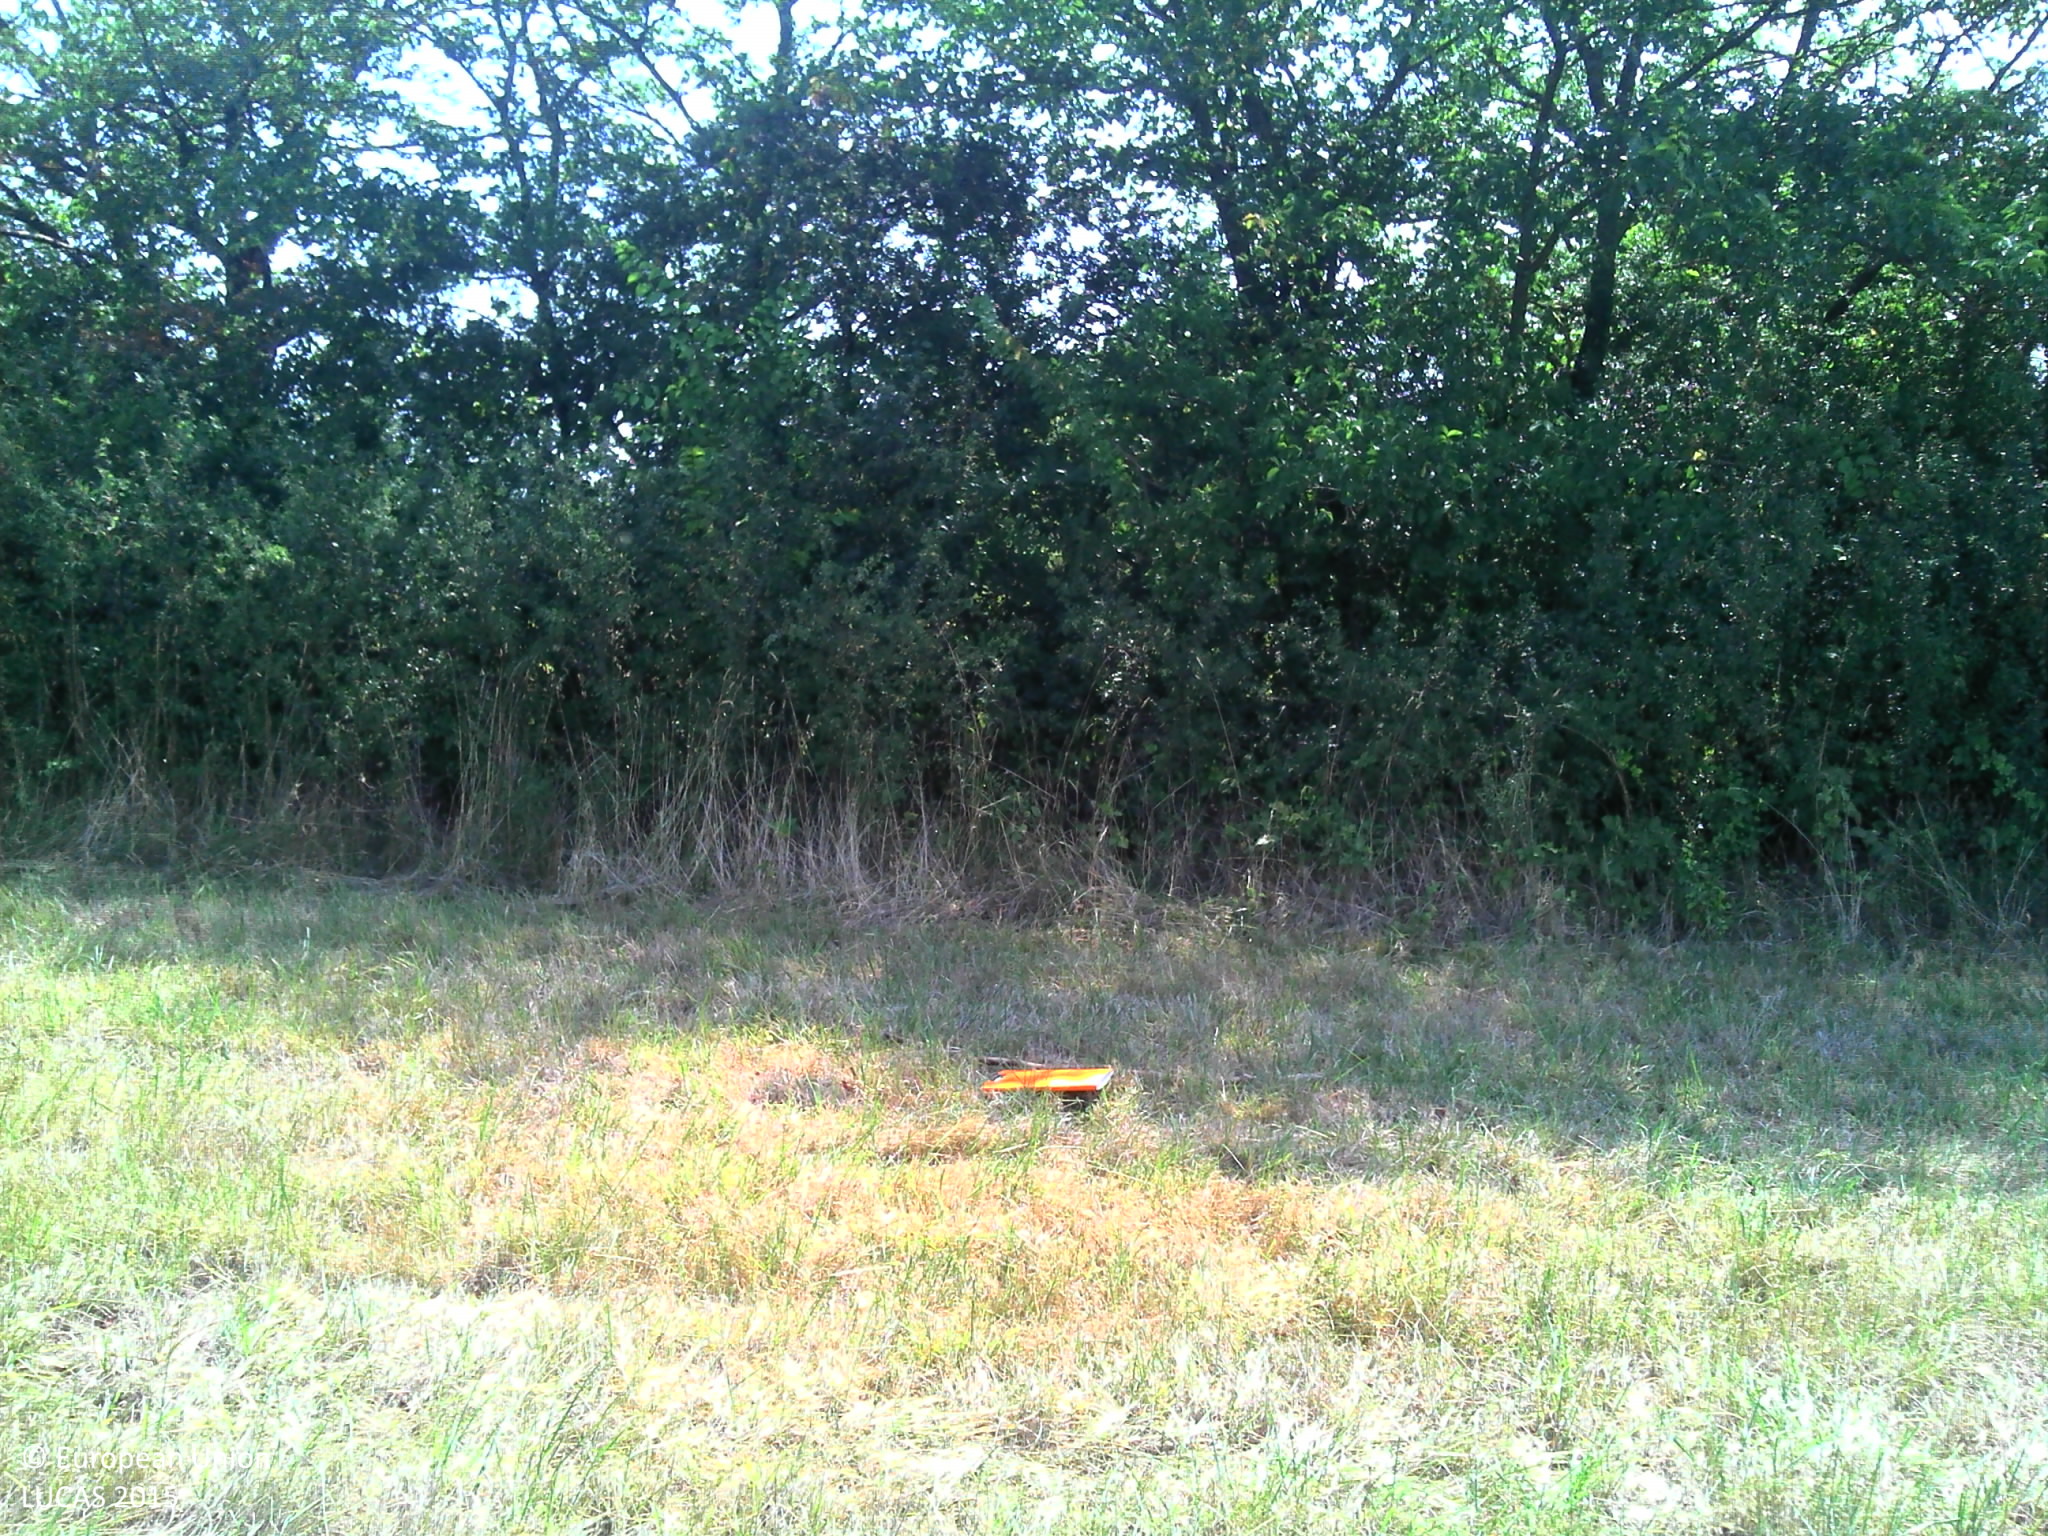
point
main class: Grassland
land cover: Grassland without tree/shrub cover
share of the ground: > 75 %
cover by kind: herbaceous plants 100 %
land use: Agriculture (excluding fallow land and kitchen gardens)
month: August
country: FR
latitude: 46.7187
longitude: 2.7345
